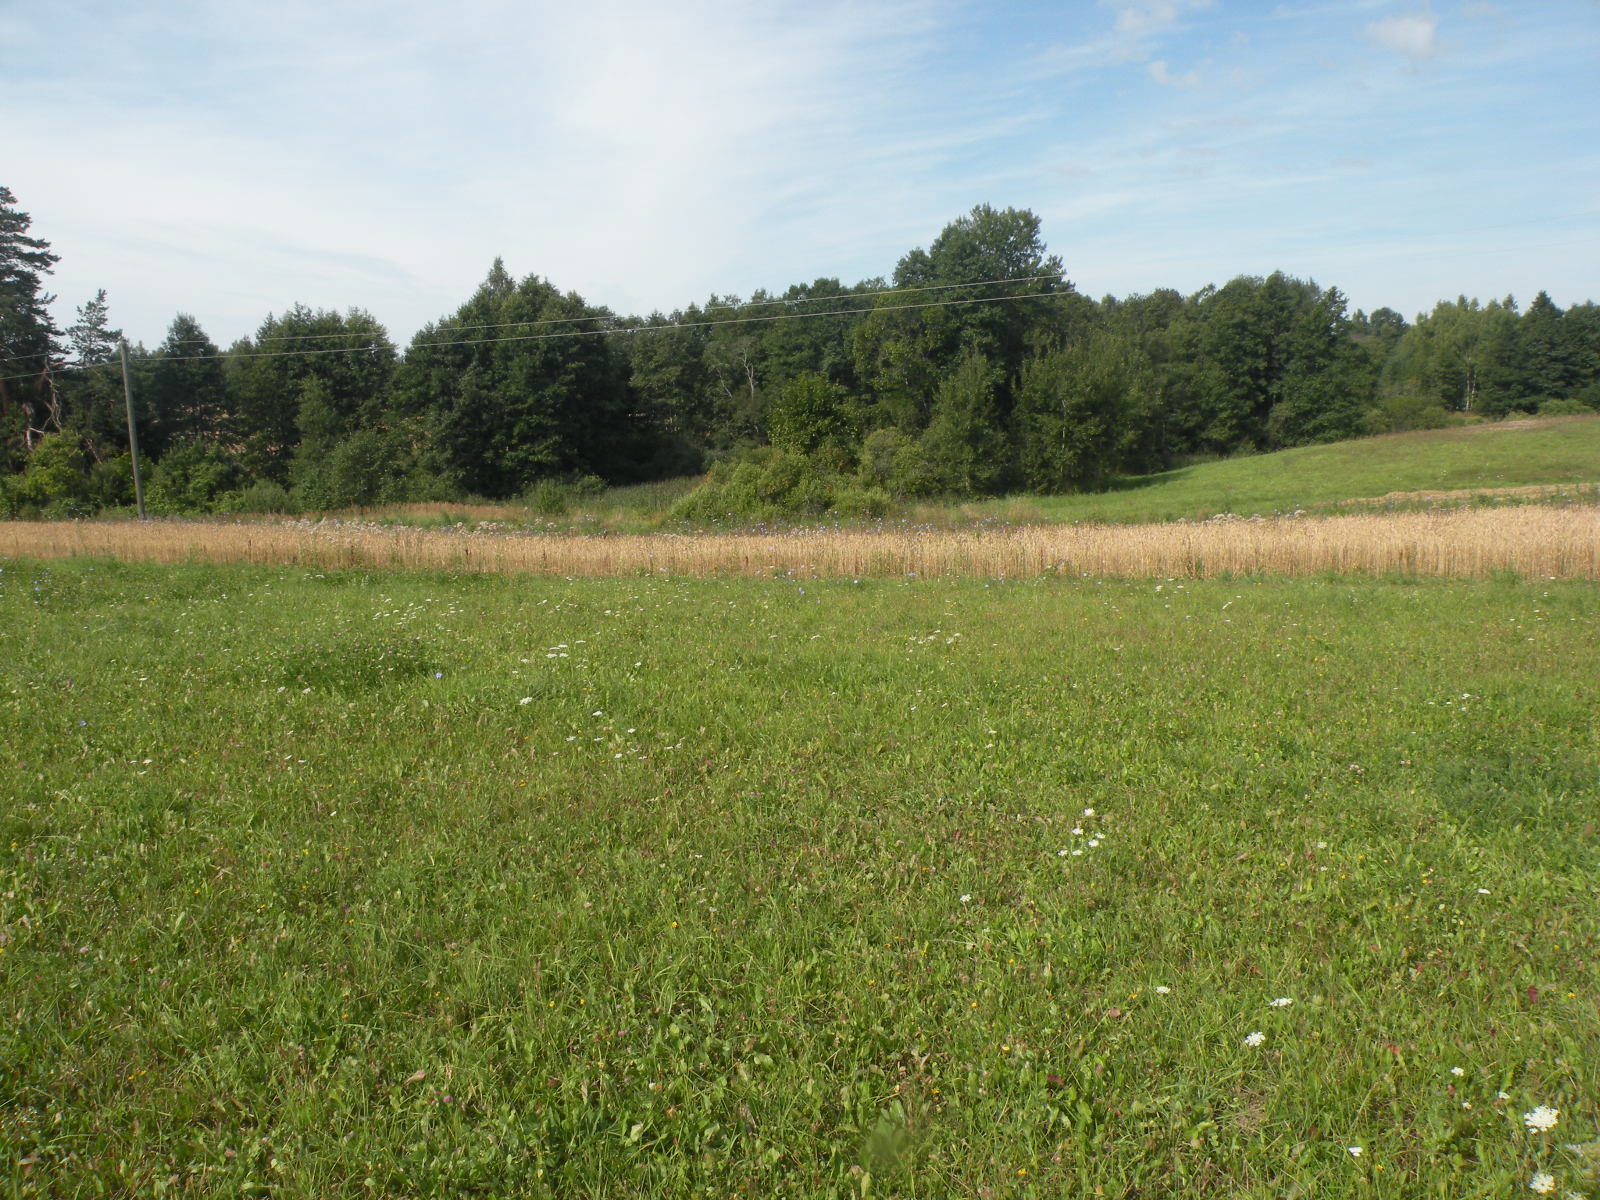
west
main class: Grassland
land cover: Grassland without tree/shrub cover
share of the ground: > 75 %
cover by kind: herbaceous plants 100 %
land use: Agriculture (excluding fallow land and kitchen gardens)
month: August
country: LV
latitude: 55.9132
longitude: 26.2542
